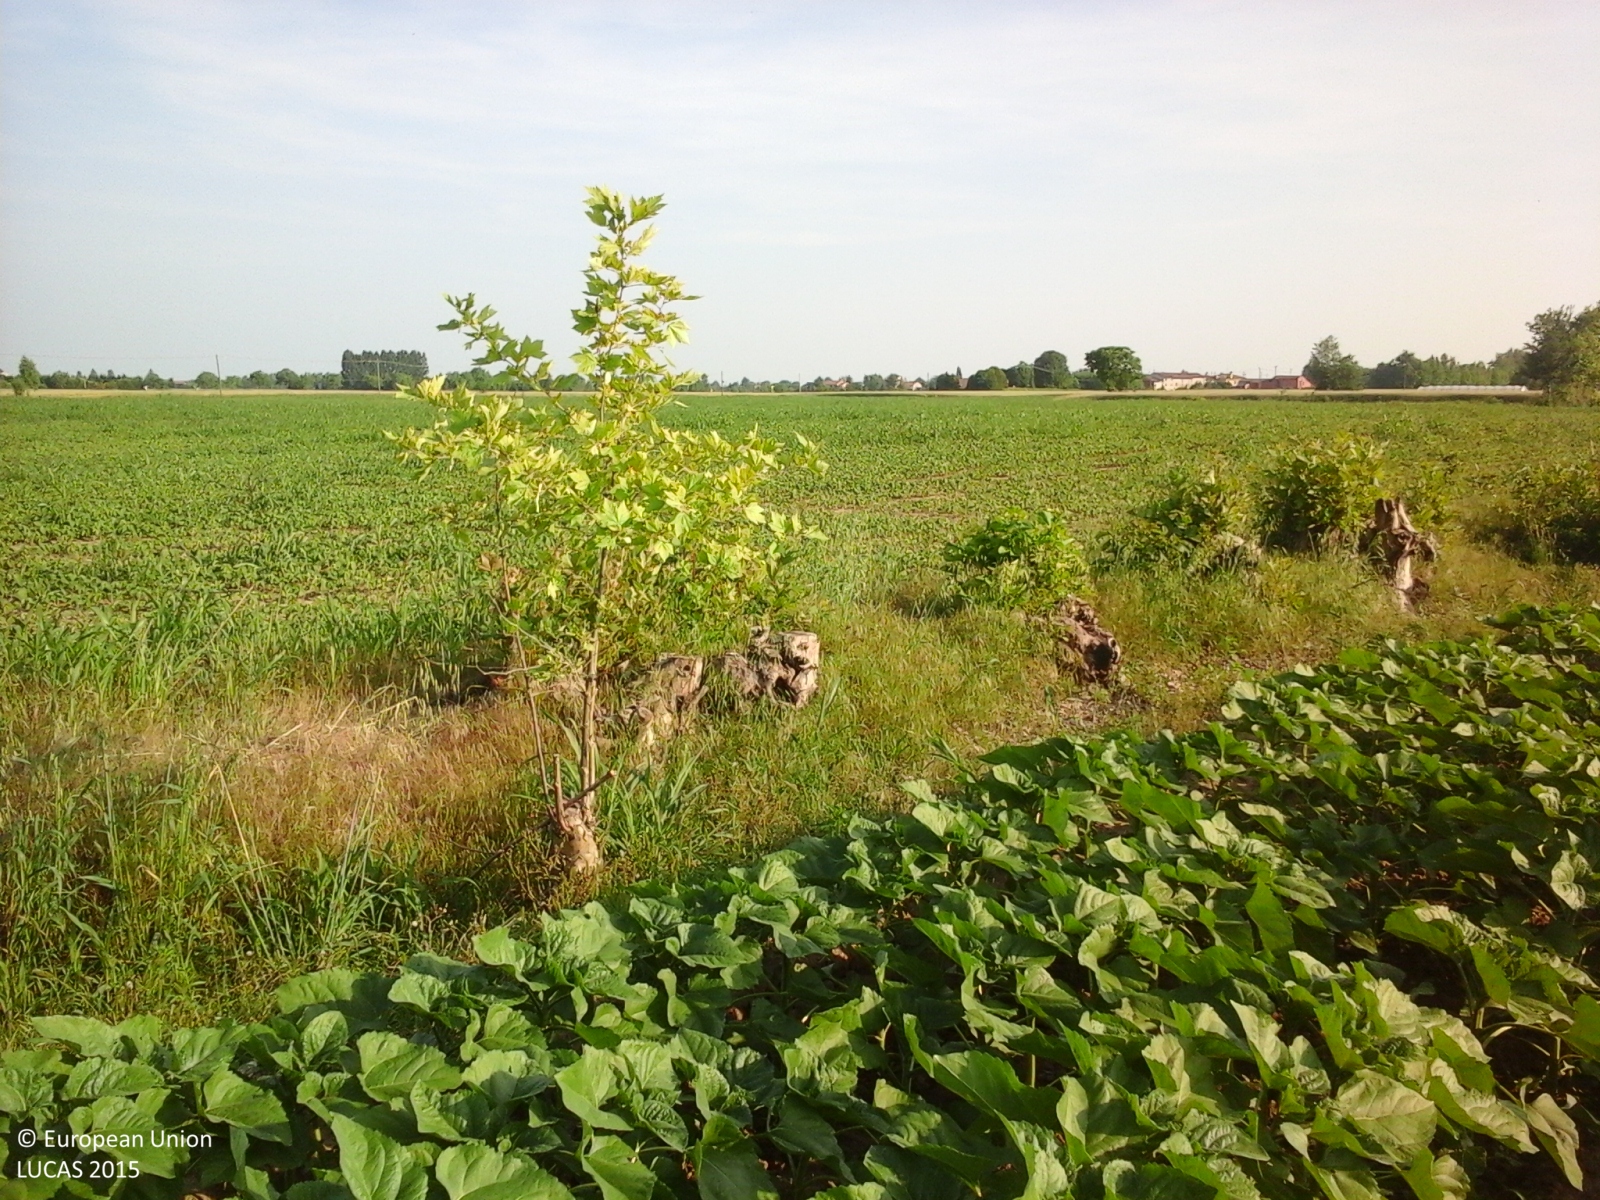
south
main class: Cropland
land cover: Sunflower
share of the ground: > 75 %
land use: Agriculture (excluding fallow land and kitchen gardens)
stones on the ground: < 10 %
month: May
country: IT
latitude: 45.2302
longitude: 10.9027
